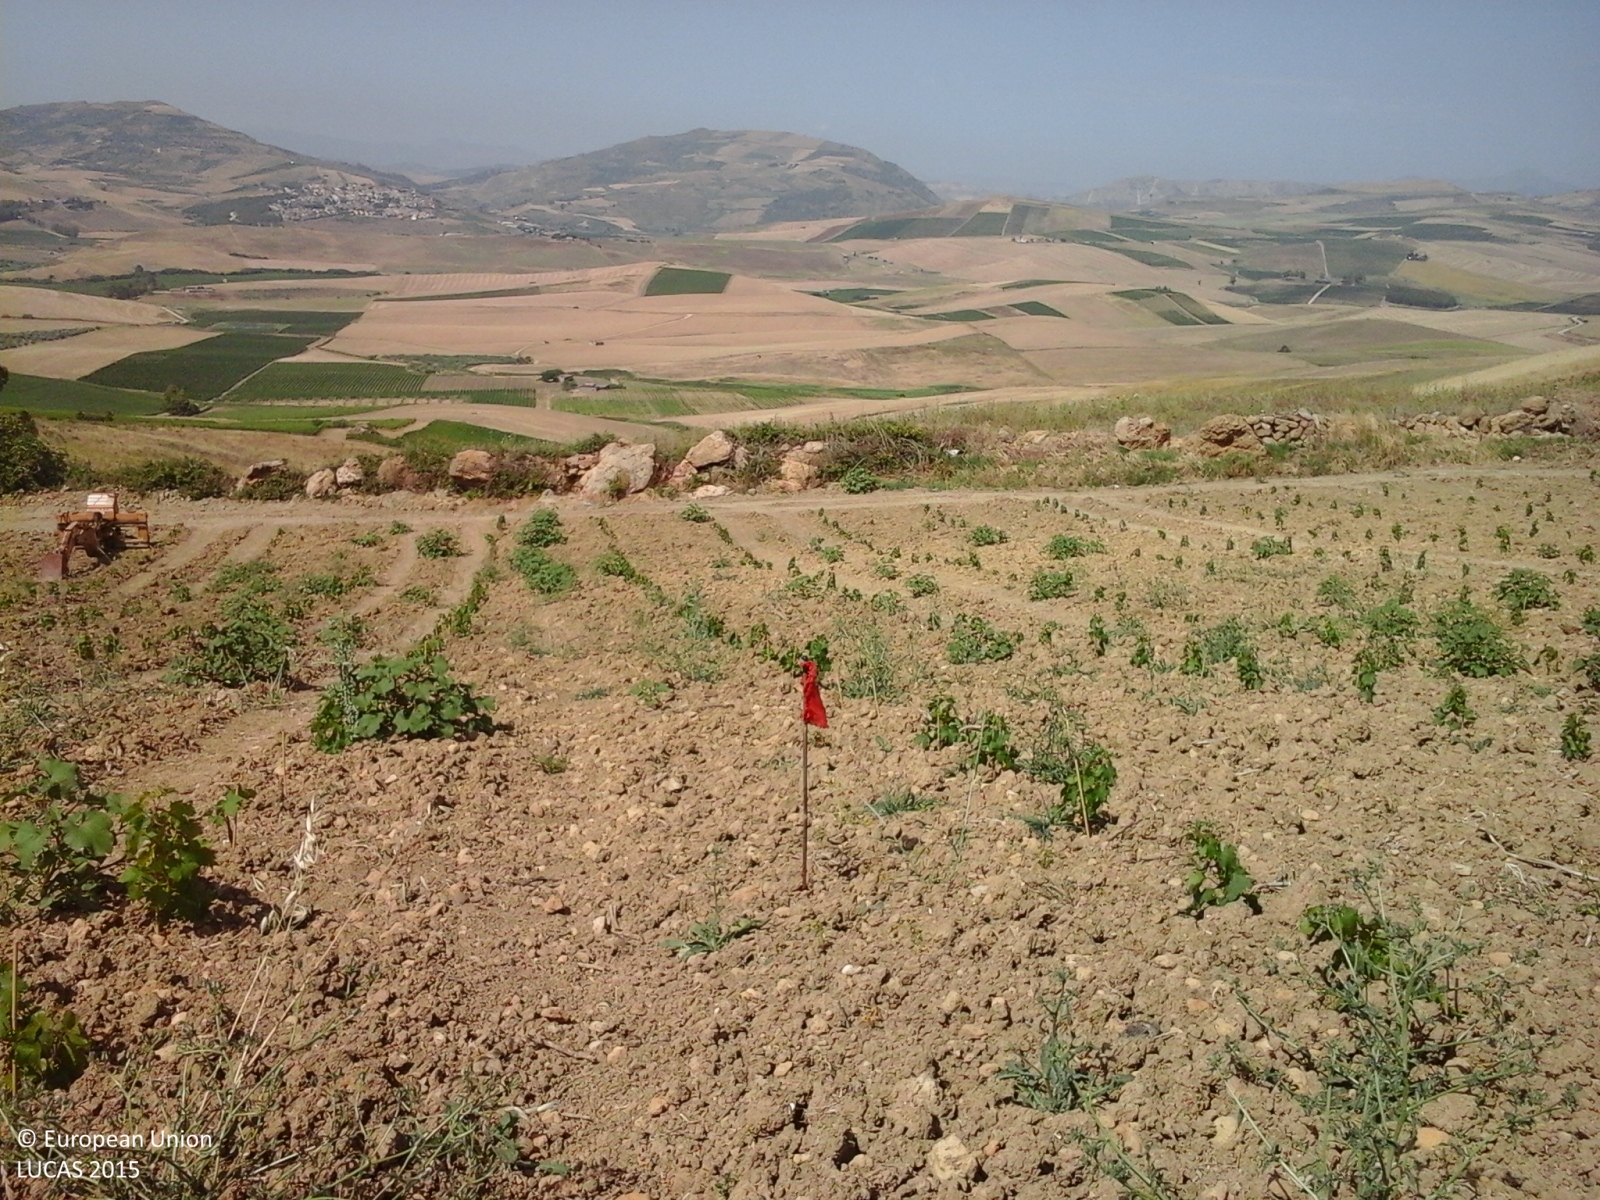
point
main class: Cropland
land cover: Vineyards
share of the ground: < 10 %
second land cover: Other bare soil
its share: > 75 %
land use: Agriculture (excluding fallow land and kitchen gardens)
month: June
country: IT
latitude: 37.7182
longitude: 13.0065
